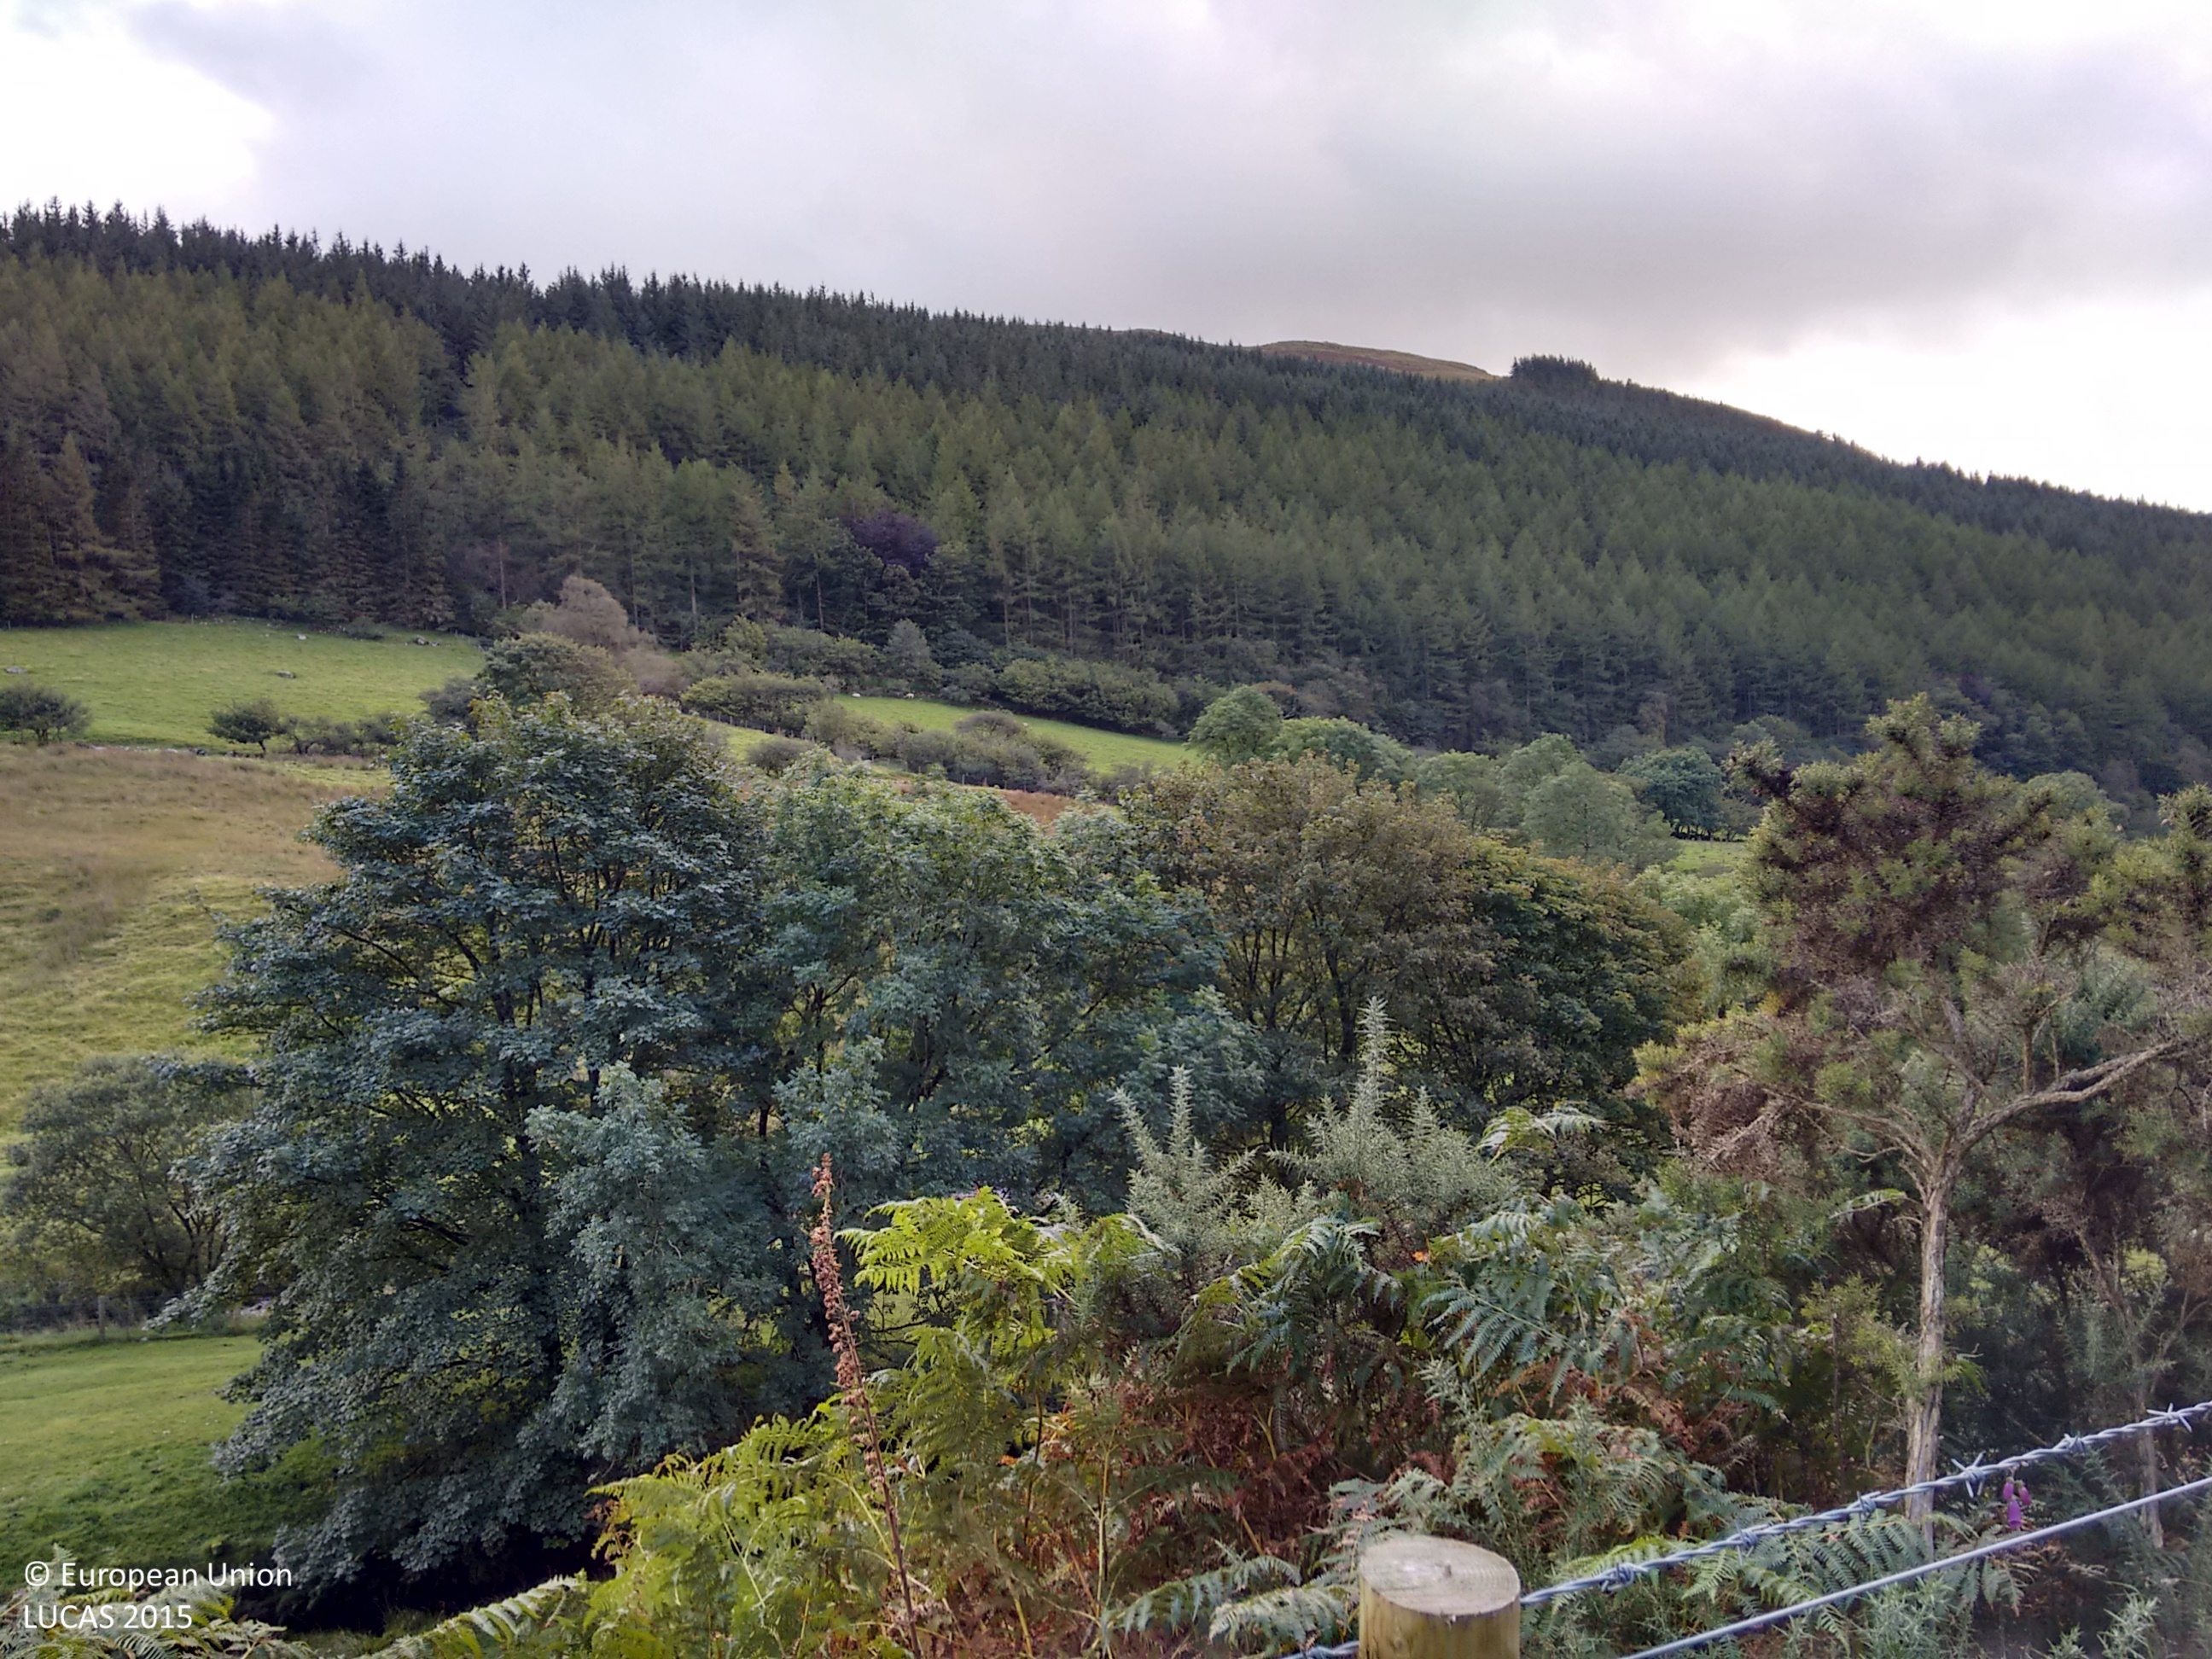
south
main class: Woodland
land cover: Other coniferous woodland
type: exotic forest
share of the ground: > 75 %
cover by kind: coniferous forest trees 100 %
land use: Forestry
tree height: > 5 m
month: September
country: GB
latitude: 52.8163
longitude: -3.7244
